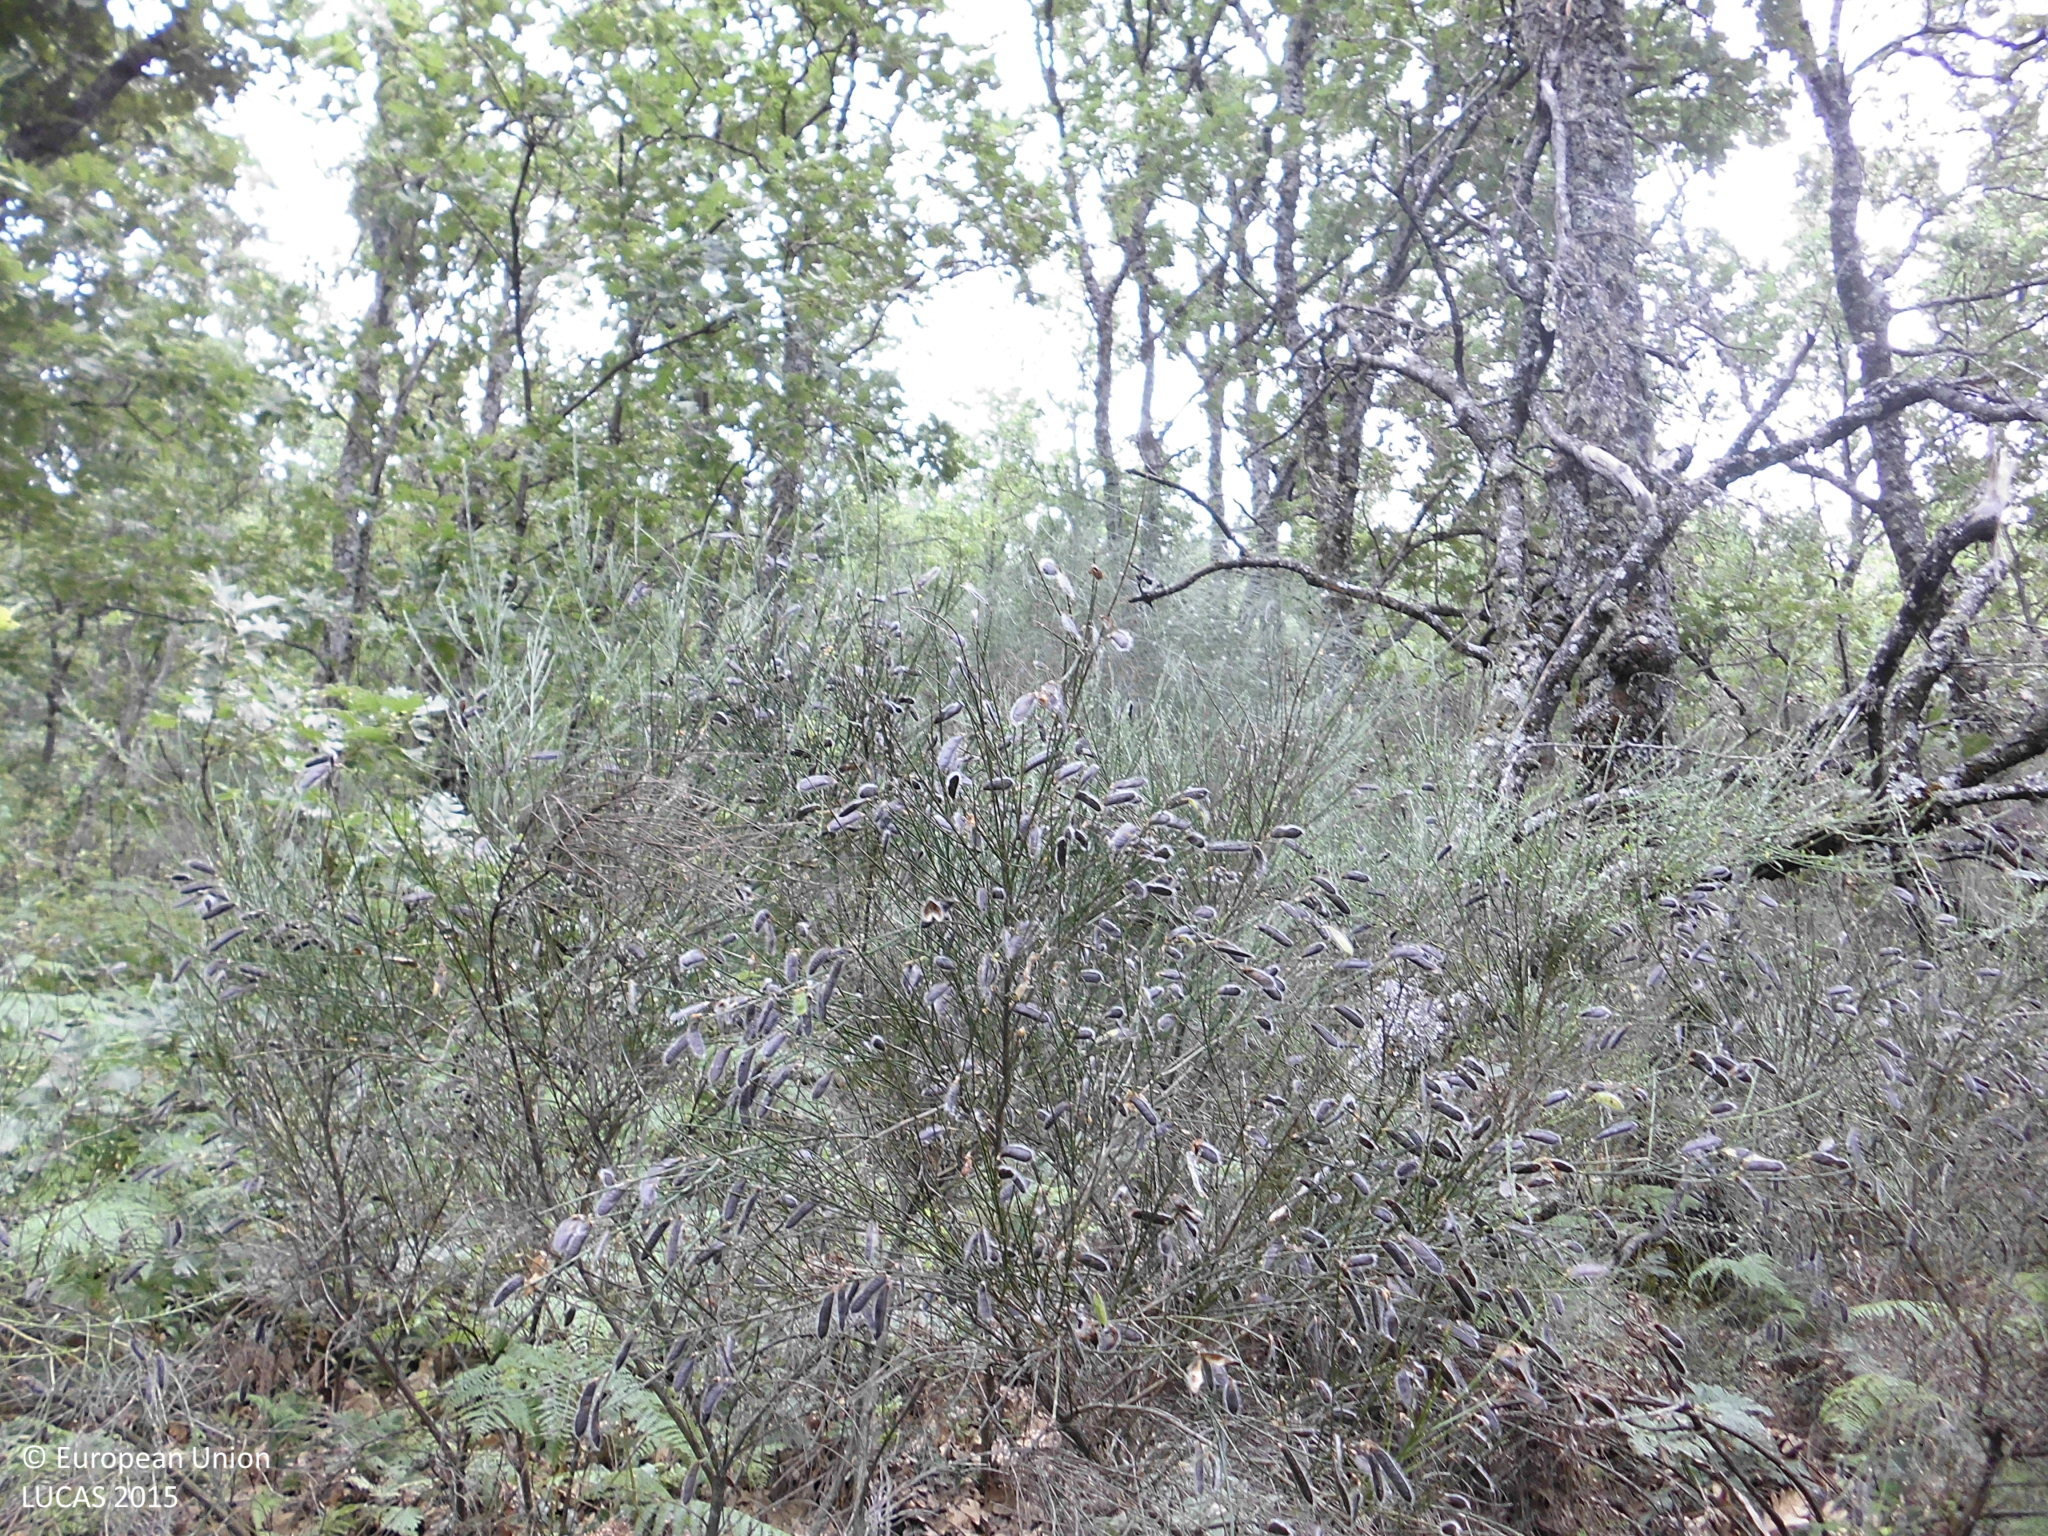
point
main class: Shrubland
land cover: Shrubland with sparse tree cover
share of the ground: > 75 %
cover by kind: shrubs 90 %, broadleaved forest trees 5 %, herbaceous plants 5 %
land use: Agriculture (excluding fallow land and kitchen gardens)
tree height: > 5 m
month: June
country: ES
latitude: 40.0575
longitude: -5.8345
